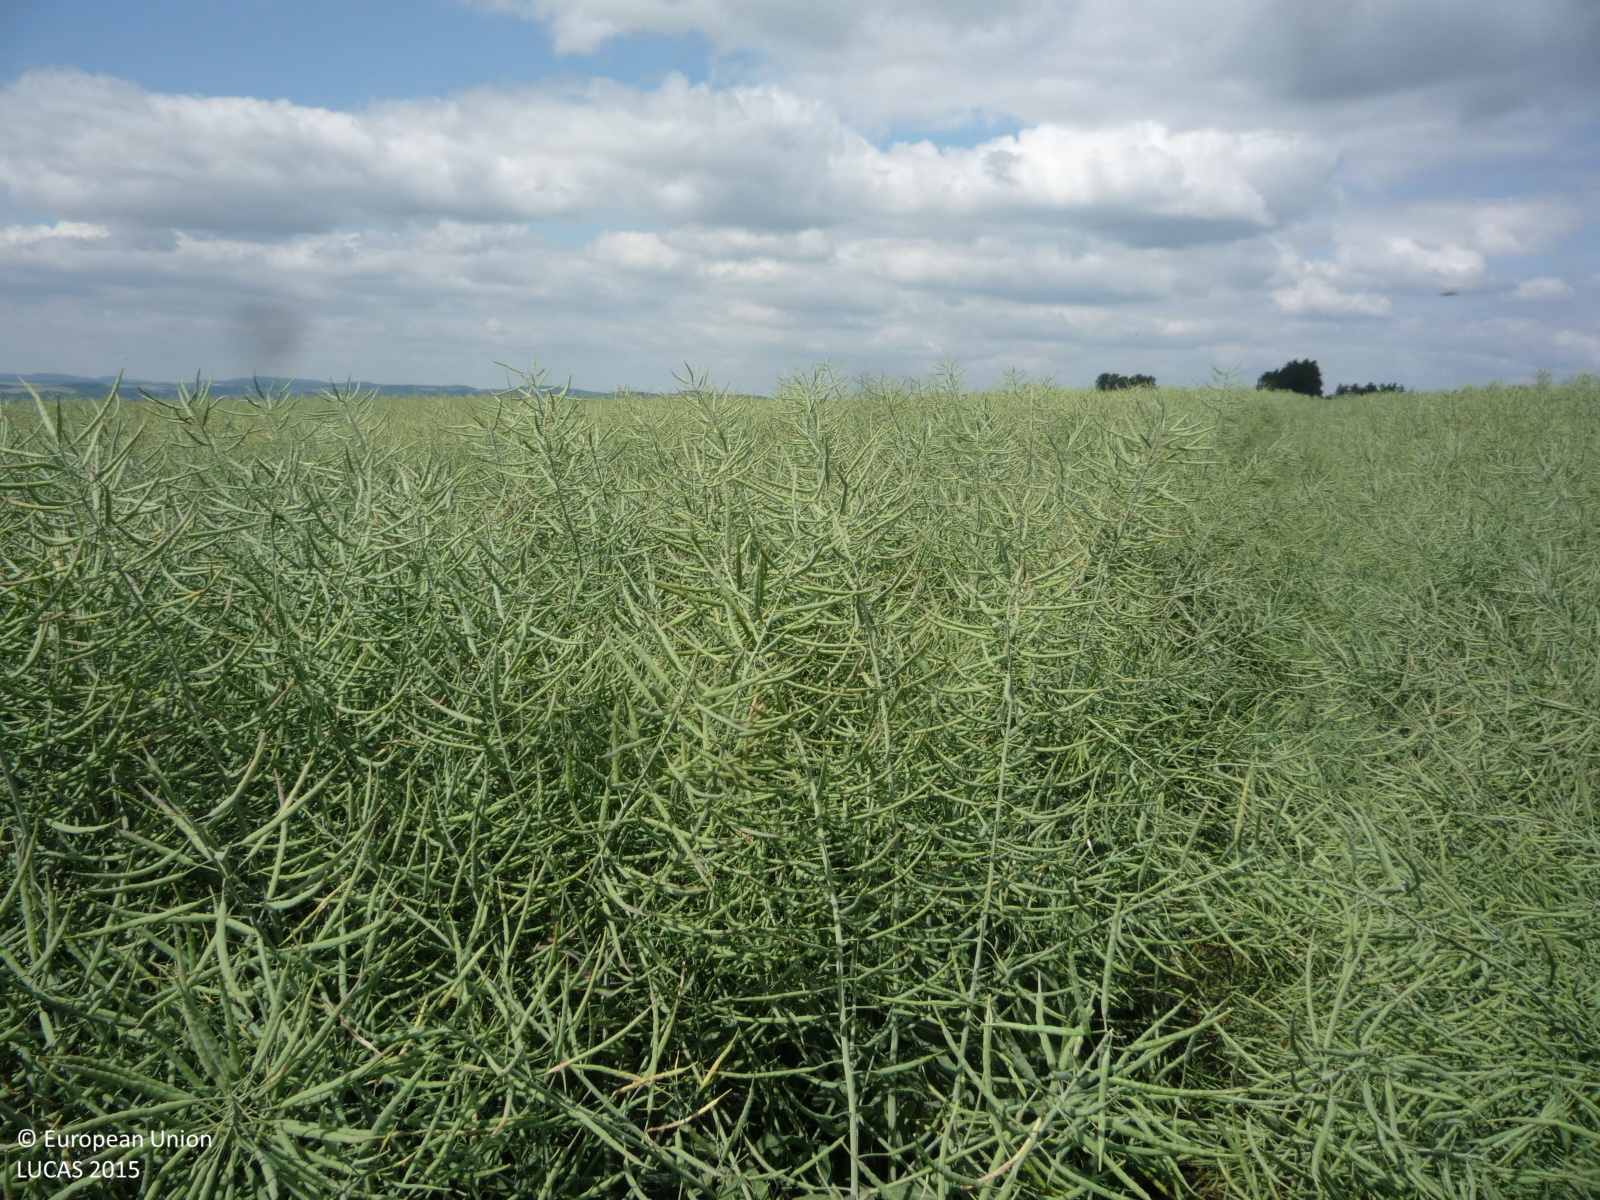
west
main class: Cropland
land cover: Rape and turnip rape
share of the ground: > 75 %
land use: Agriculture (excluding fallow land and kitchen gardens)
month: June
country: CZ
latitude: 49.7342
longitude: 14.9557
